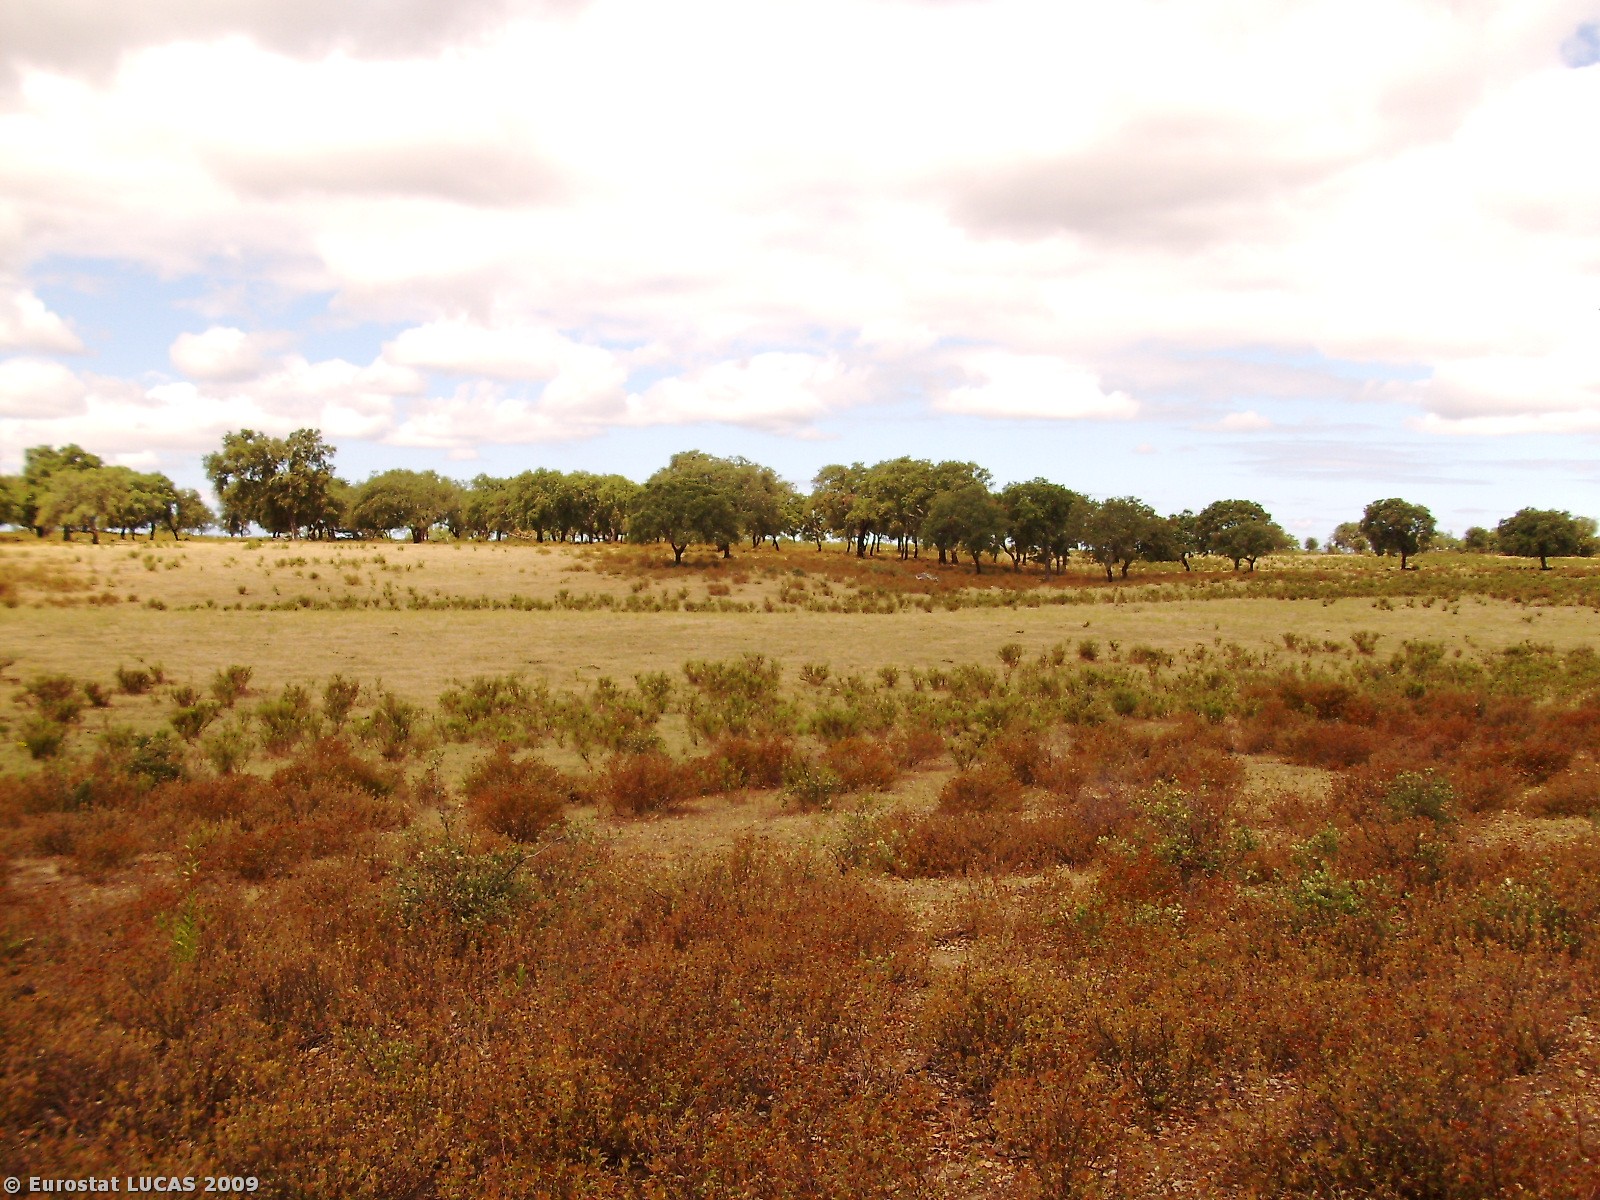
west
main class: Woodland
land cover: Broadleaved woodland
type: broadleaved evergreen forest
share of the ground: 10 - 25 %
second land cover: Shrubland with sparse tree cover
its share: 50 - 75 %
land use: Forestry
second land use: Agriculture (excluding fallow land and kitchen gardens)
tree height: > 5 m
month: June
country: PT
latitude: 37.9906
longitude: -8.5003
